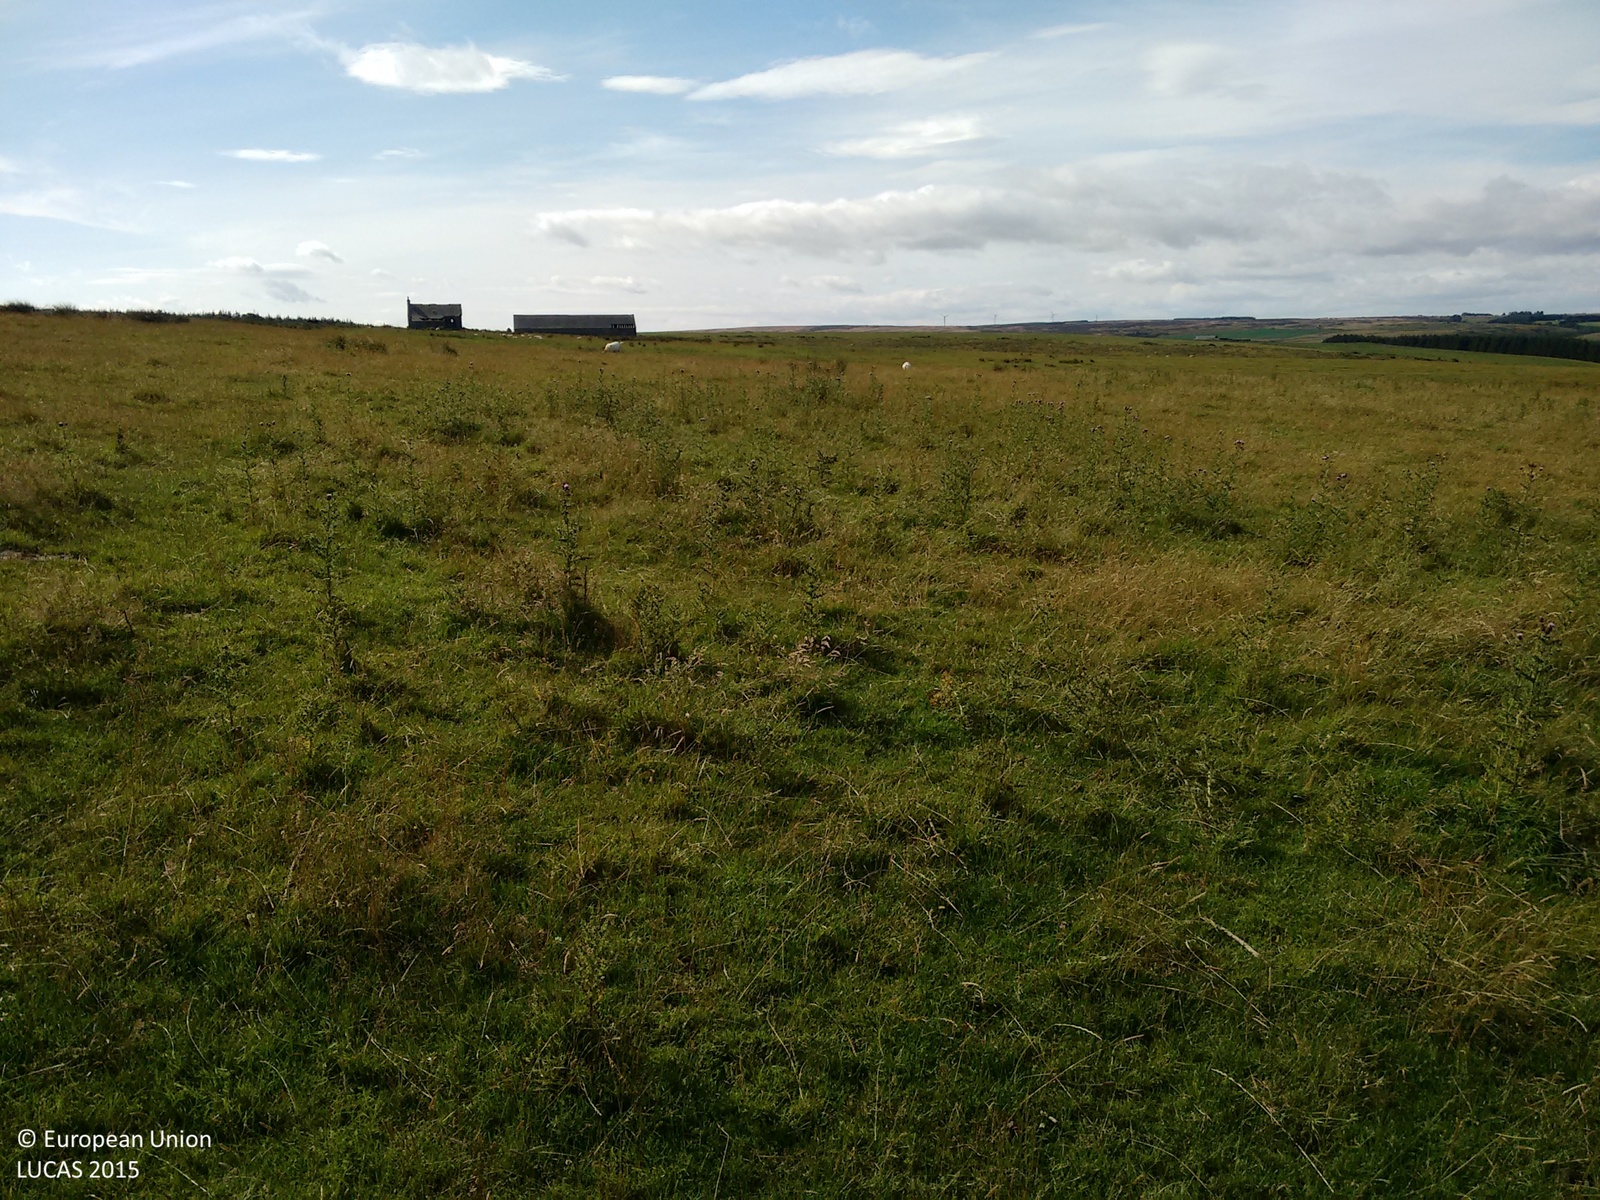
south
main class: Grassland
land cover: Grassland without tree/shrub cover
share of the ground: > 75 %
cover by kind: herbaceous plants 100 %
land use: Agriculture (excluding fallow land and kitchen gardens)
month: August
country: GB
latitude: 57.6551
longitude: -2.2651
